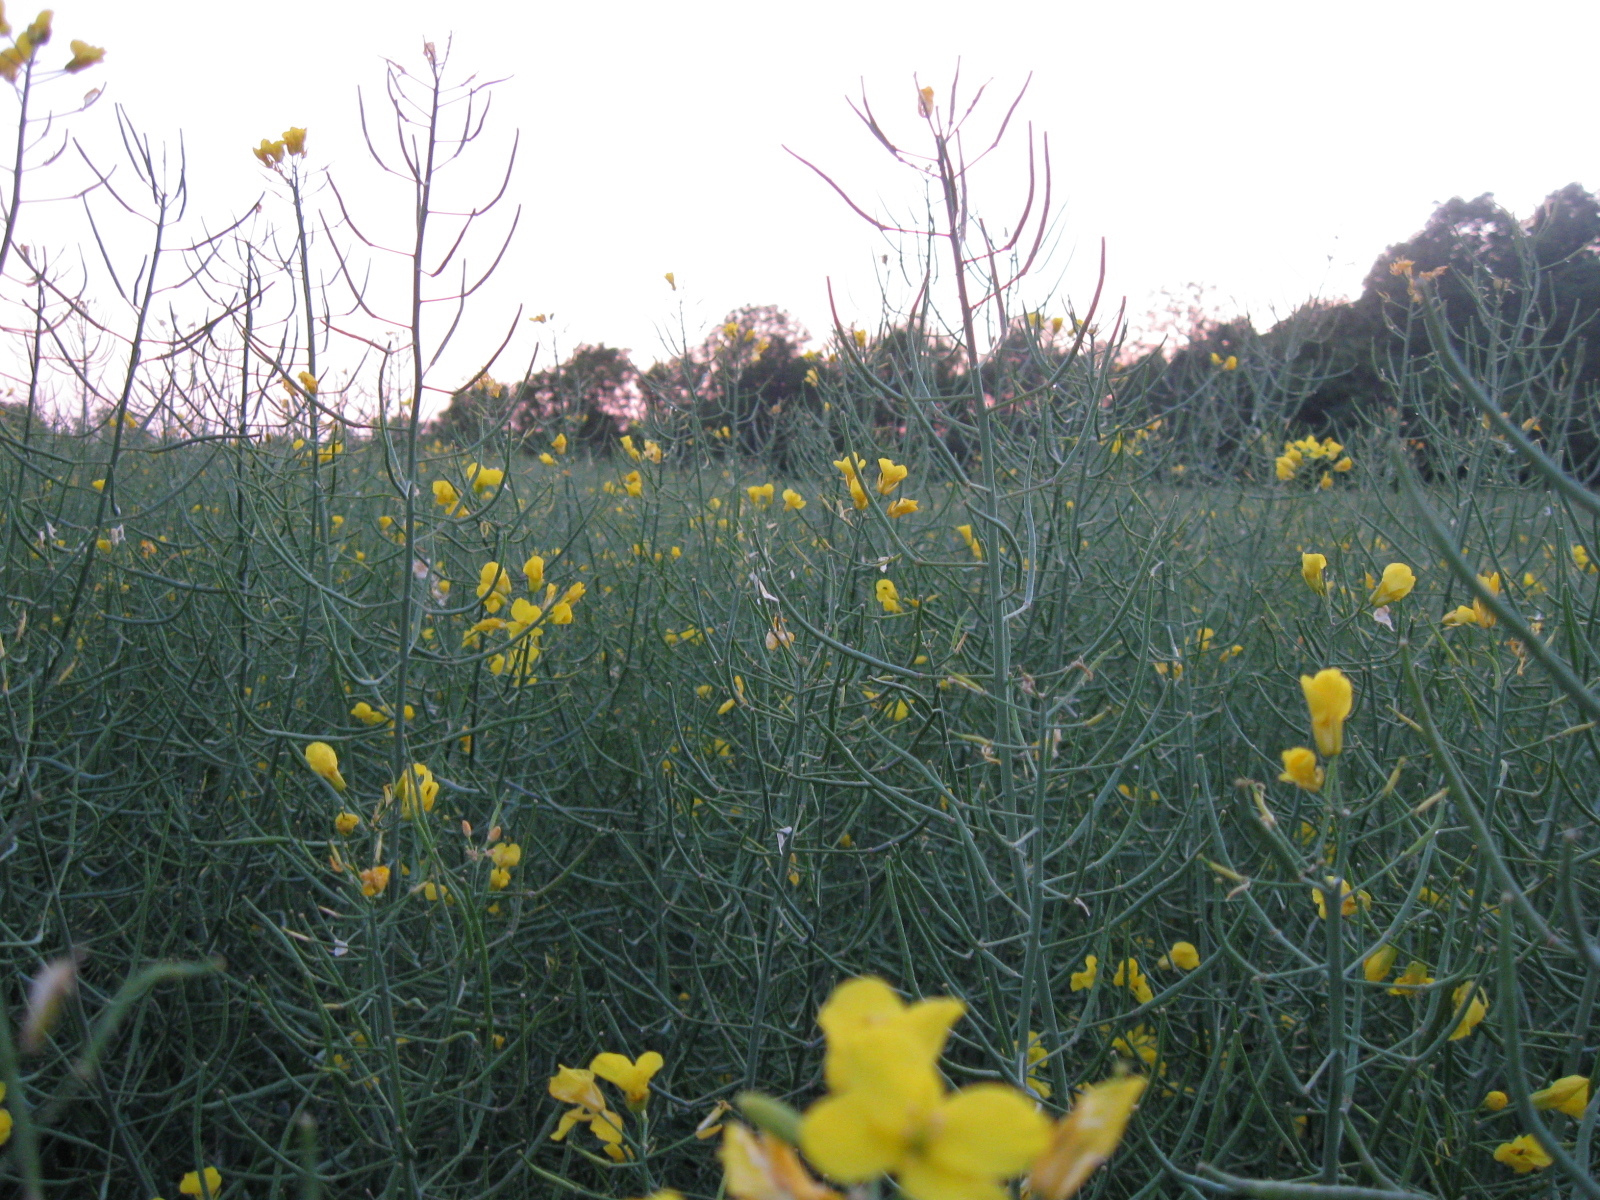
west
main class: Cropland
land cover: Rape and turnip rape
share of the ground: > 75 %
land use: Agriculture (excluding fallow land and kitchen gardens)
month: June
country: LT
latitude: 54.4827
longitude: 23.8413
